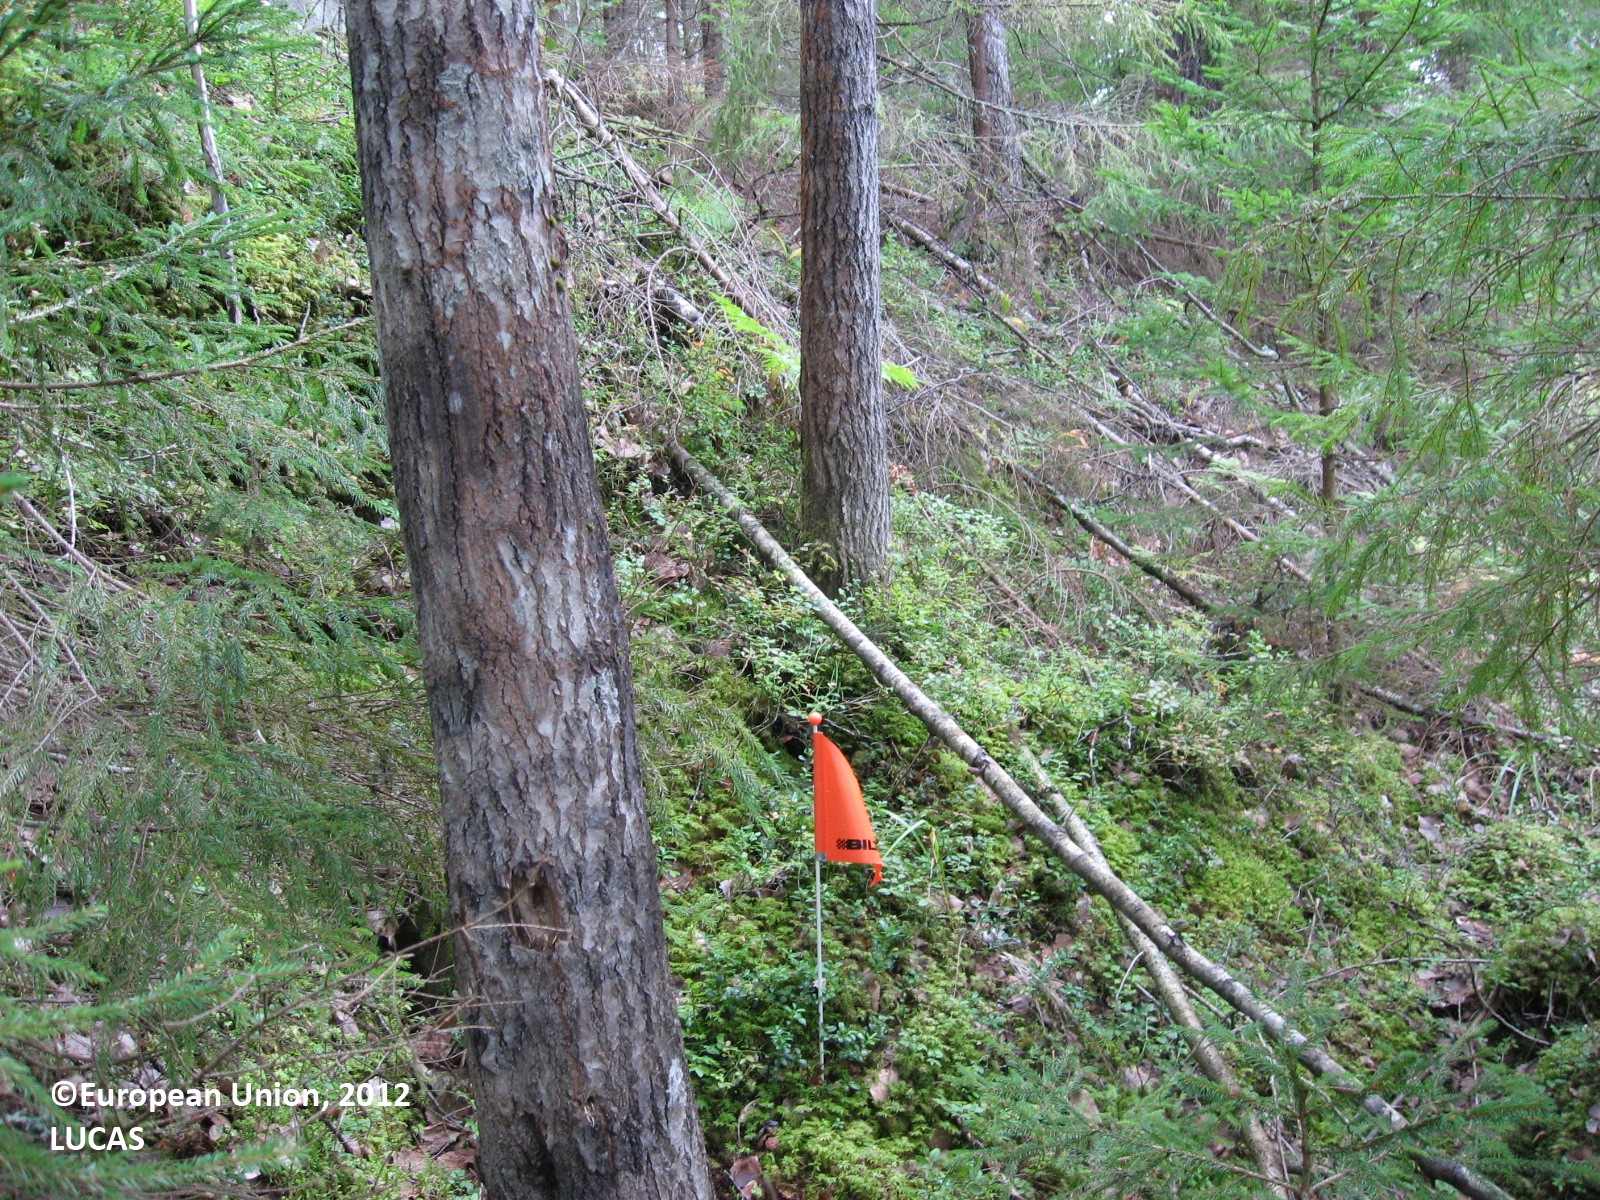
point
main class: Woodland
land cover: Spruce dominated mixed woodland
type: boreal forest
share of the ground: > 75 %
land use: Forestry
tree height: > 5 m
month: August
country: FI
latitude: 60.9108
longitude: 25.5612
